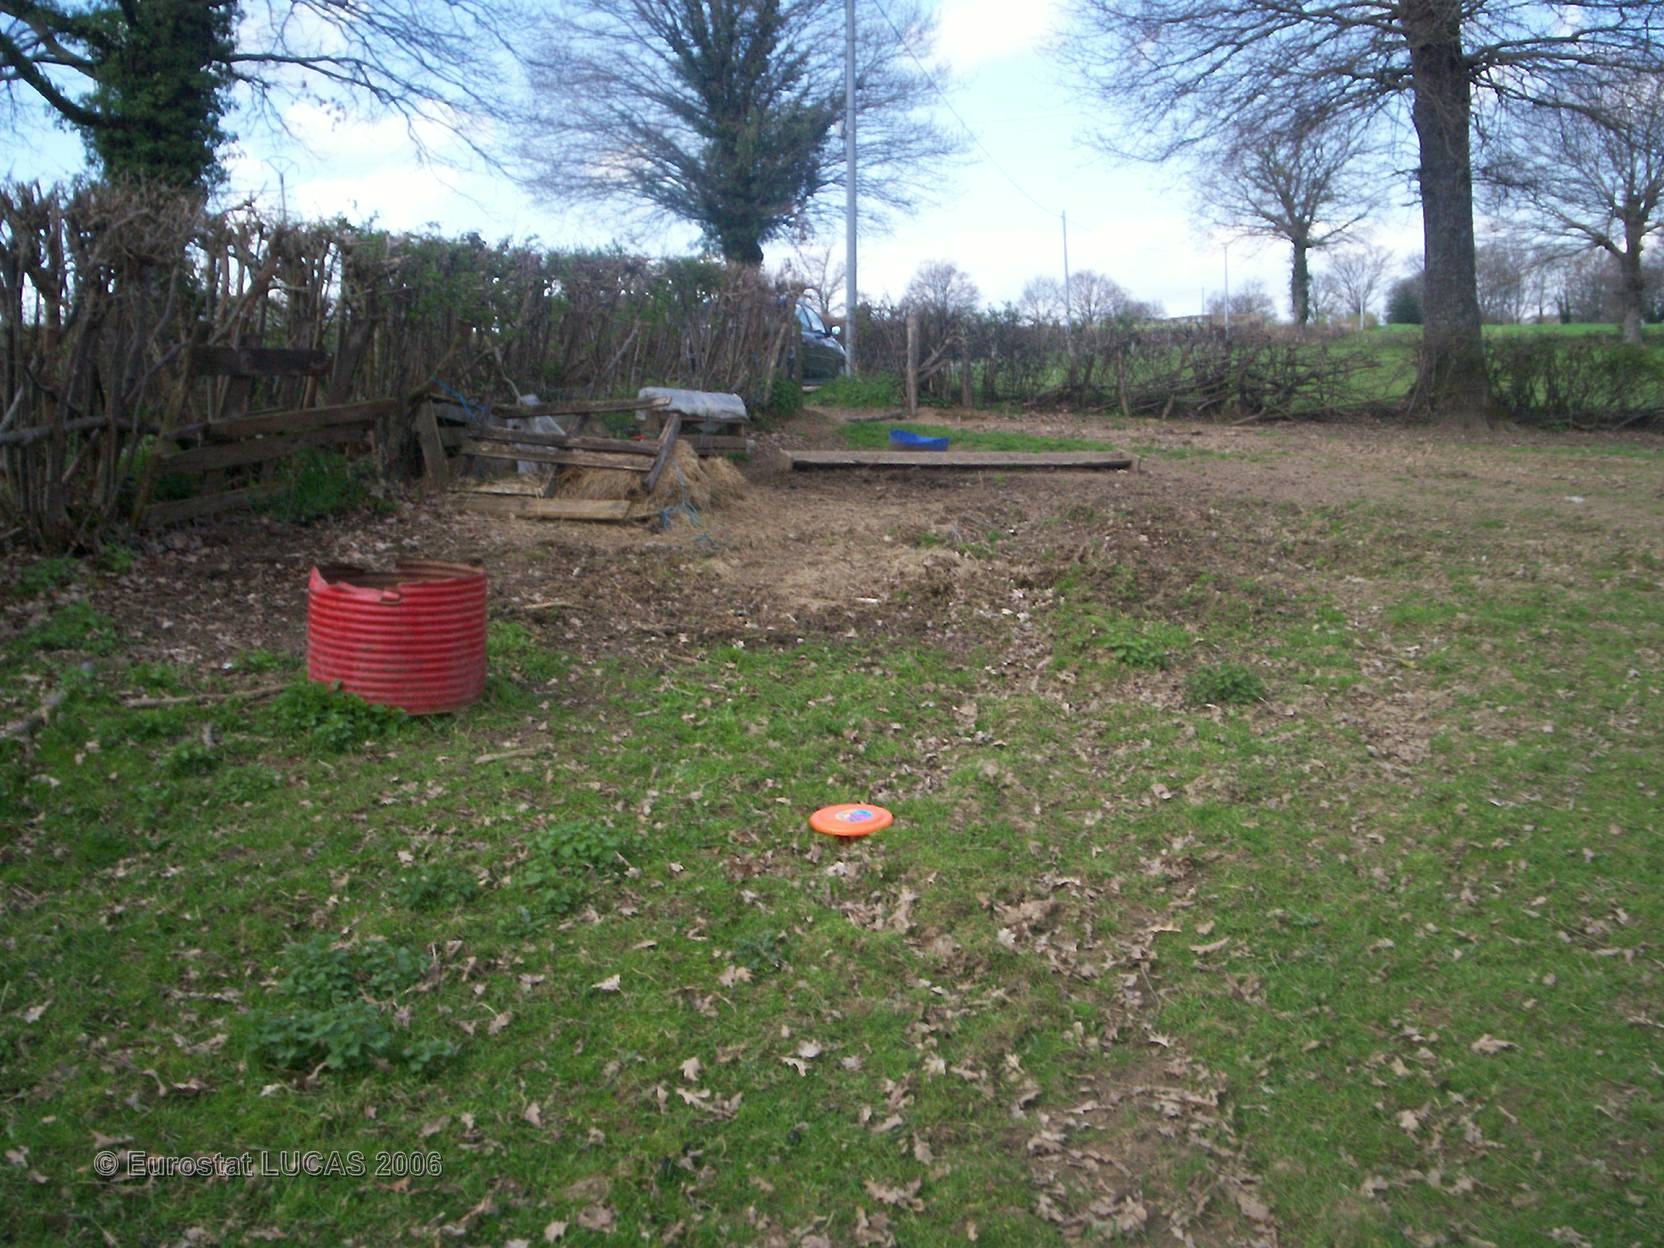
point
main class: Grassland
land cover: Grassland without tree/shrub cover
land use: Agriculture (excluding fallow land and kitchen gardens)
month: April
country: FR
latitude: 46.4117
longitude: 3.0115
